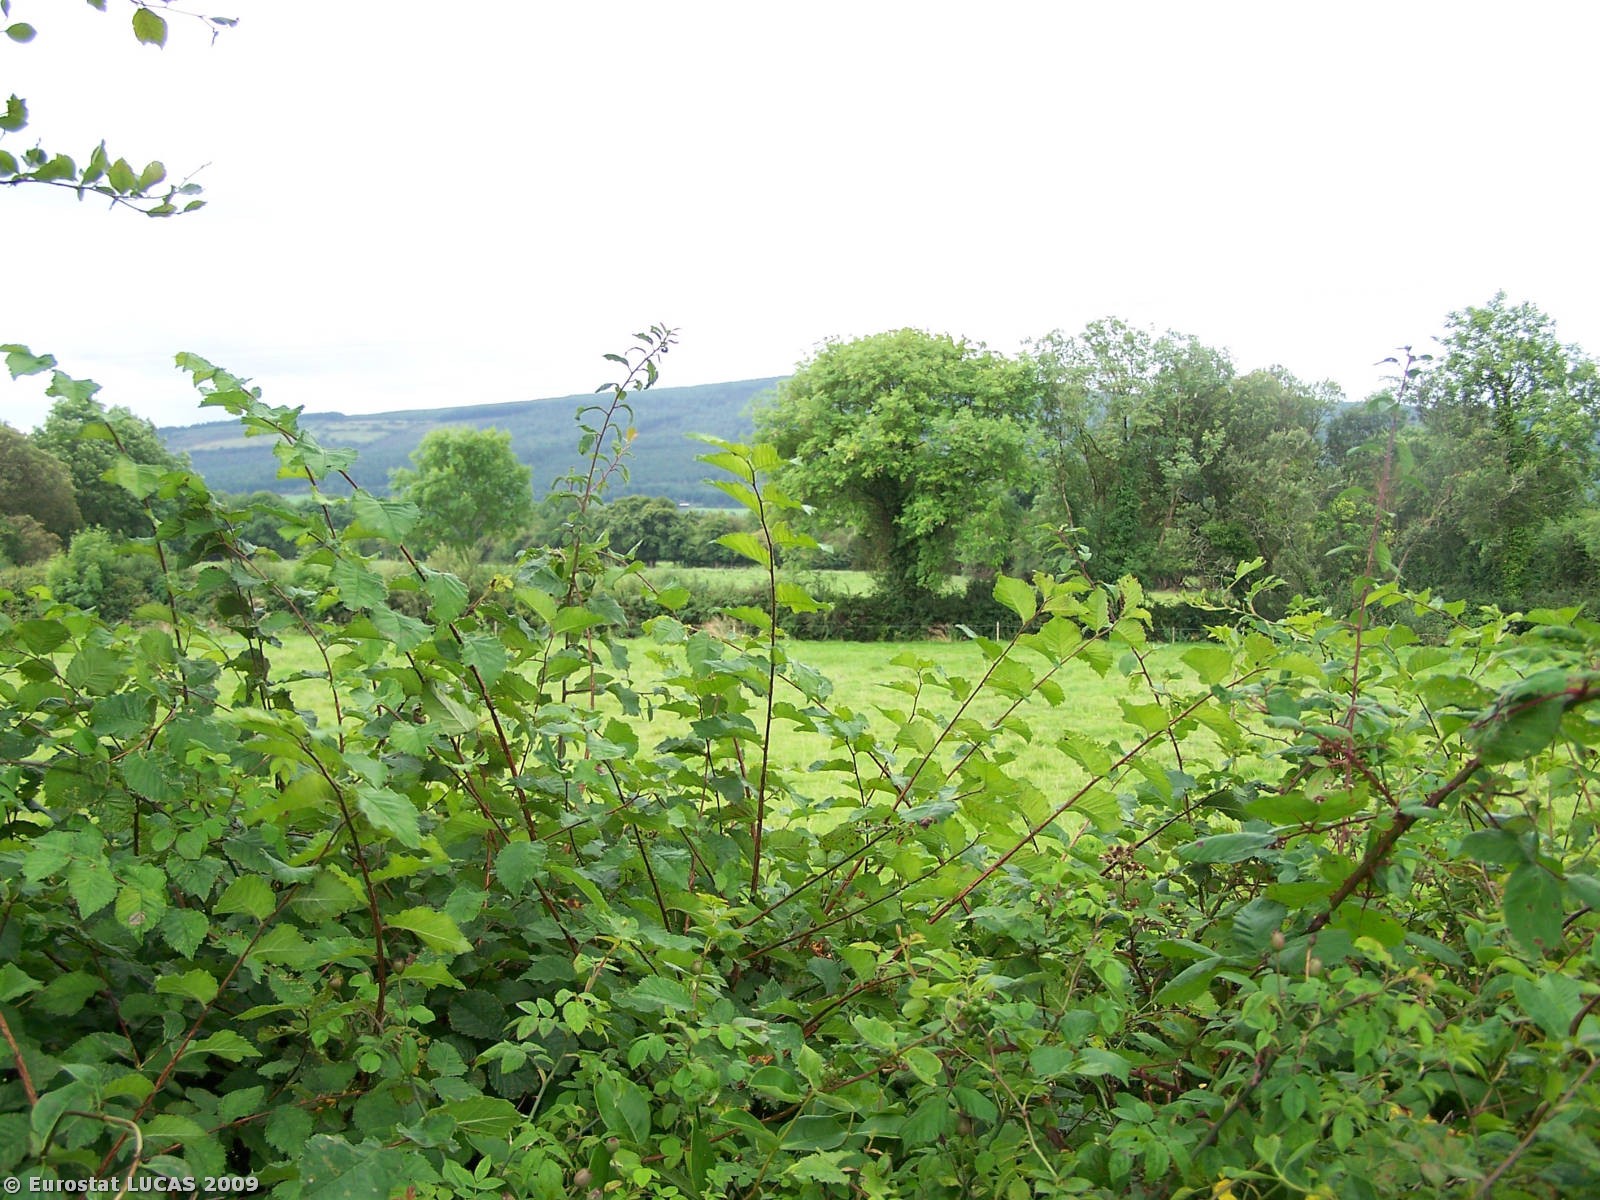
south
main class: Grassland
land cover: Grassland without tree/shrub cover
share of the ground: > 75 %
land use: Agriculture (excluding fallow land and kitchen gardens)
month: August
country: IE
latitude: 52.1432
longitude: -8.8378
